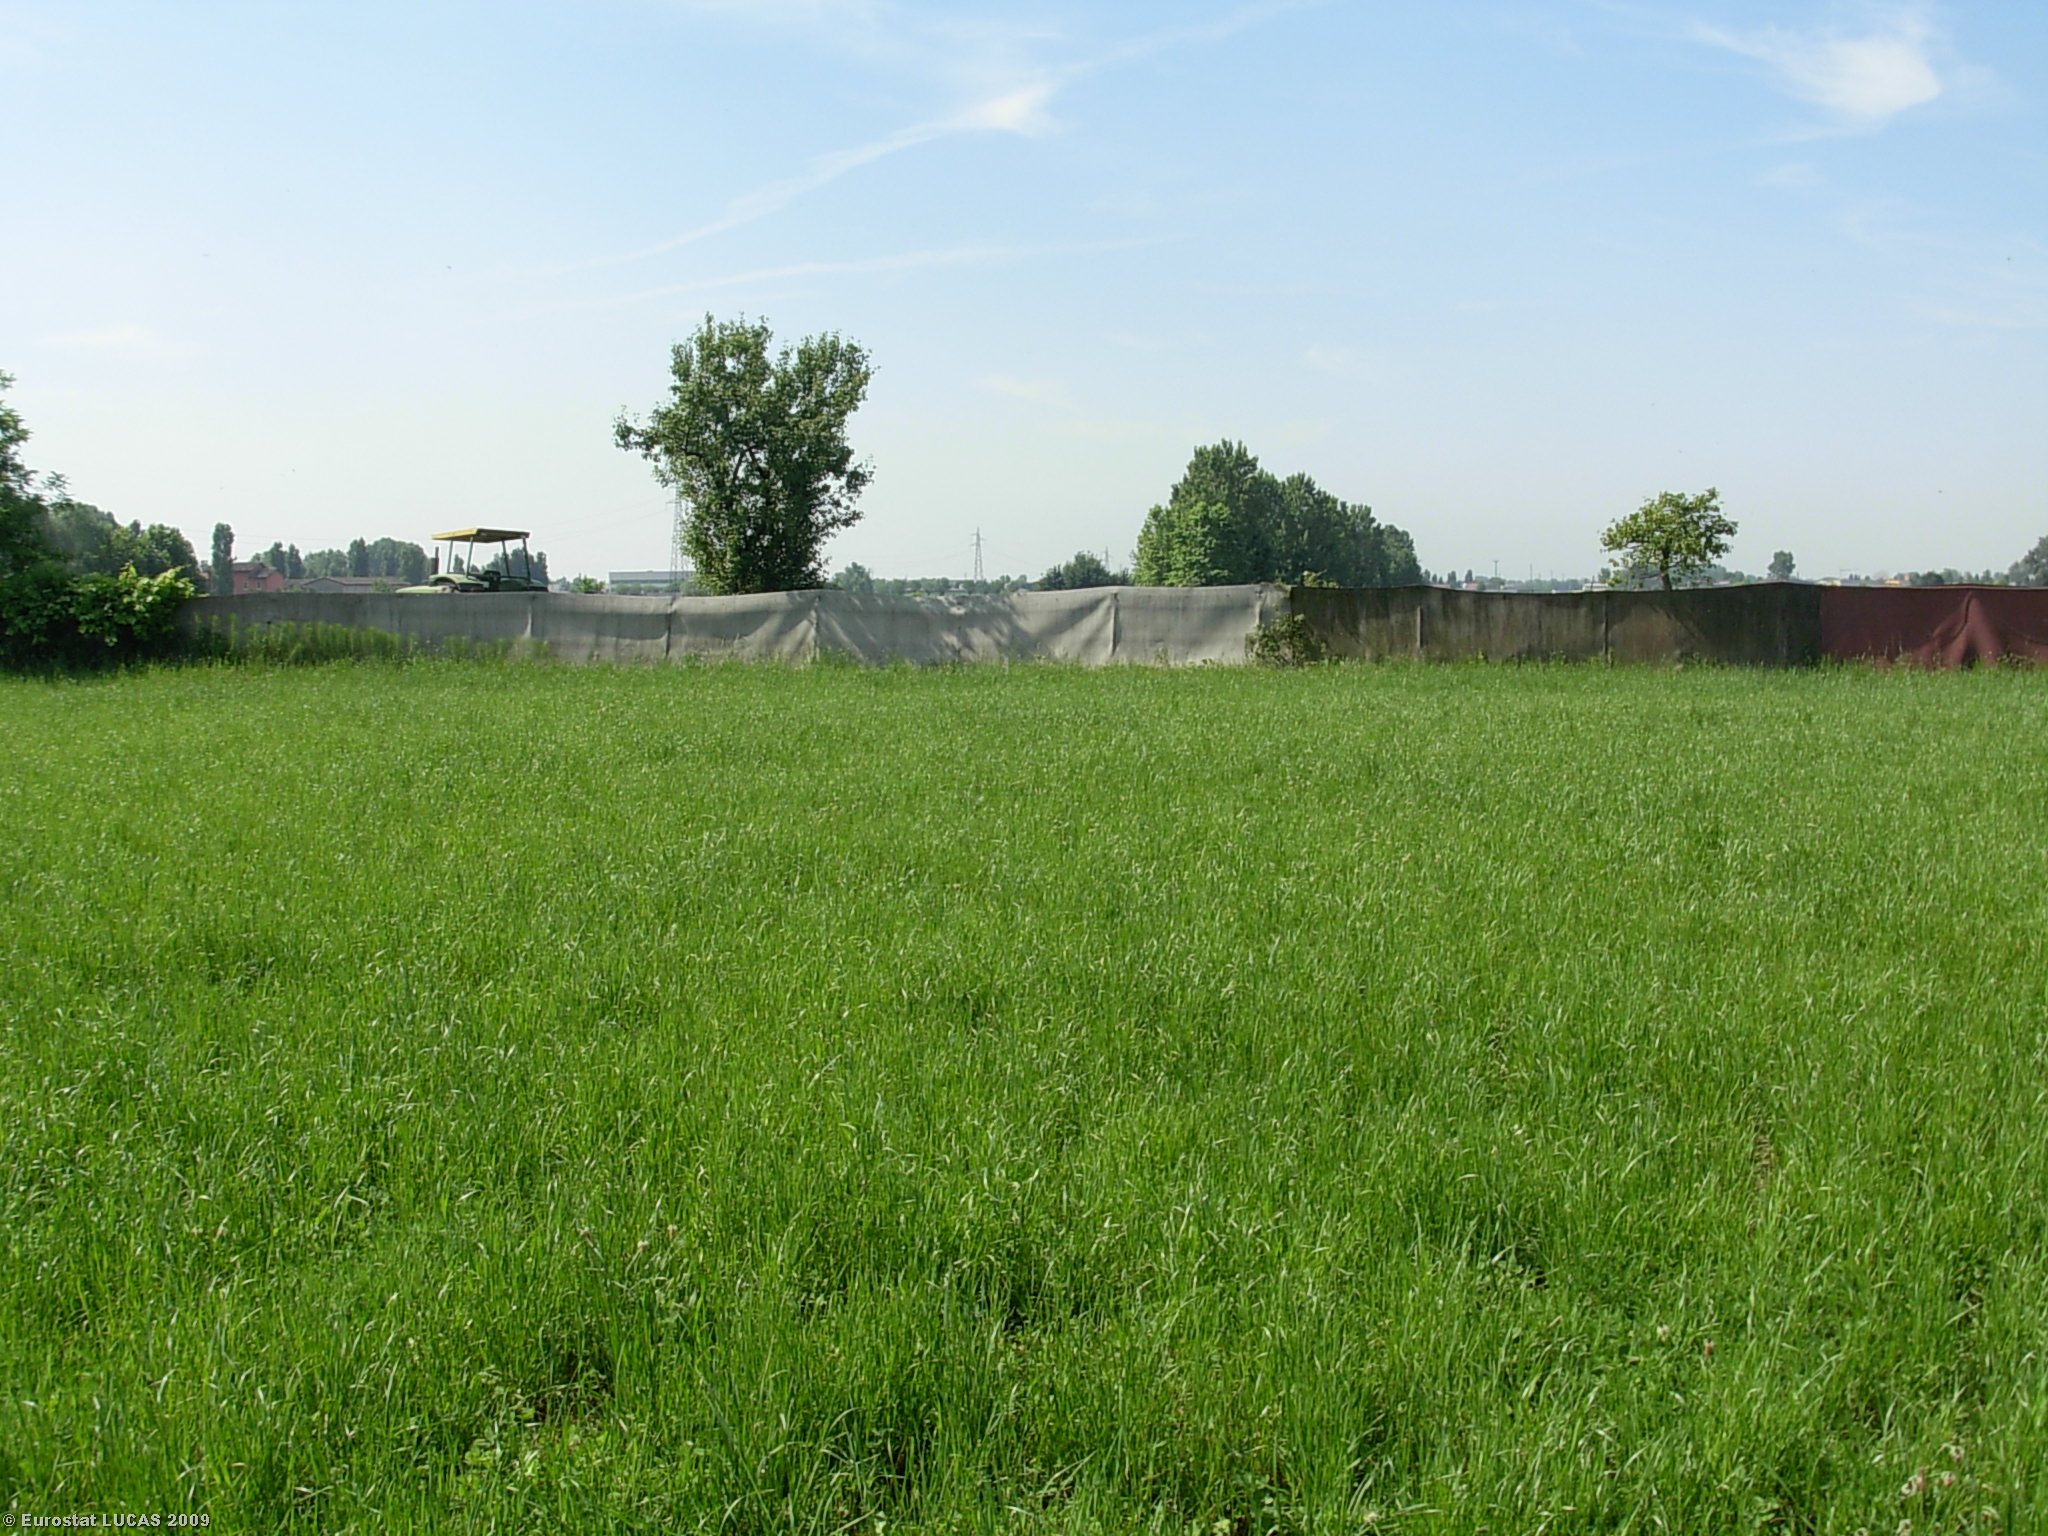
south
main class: Grassland
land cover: Grassland without tree/shrub cover
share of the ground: > 75 %
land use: Agriculture (excluding fallow land and kitchen gardens)
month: June
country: IT
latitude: 45.3236
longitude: 10.3438
